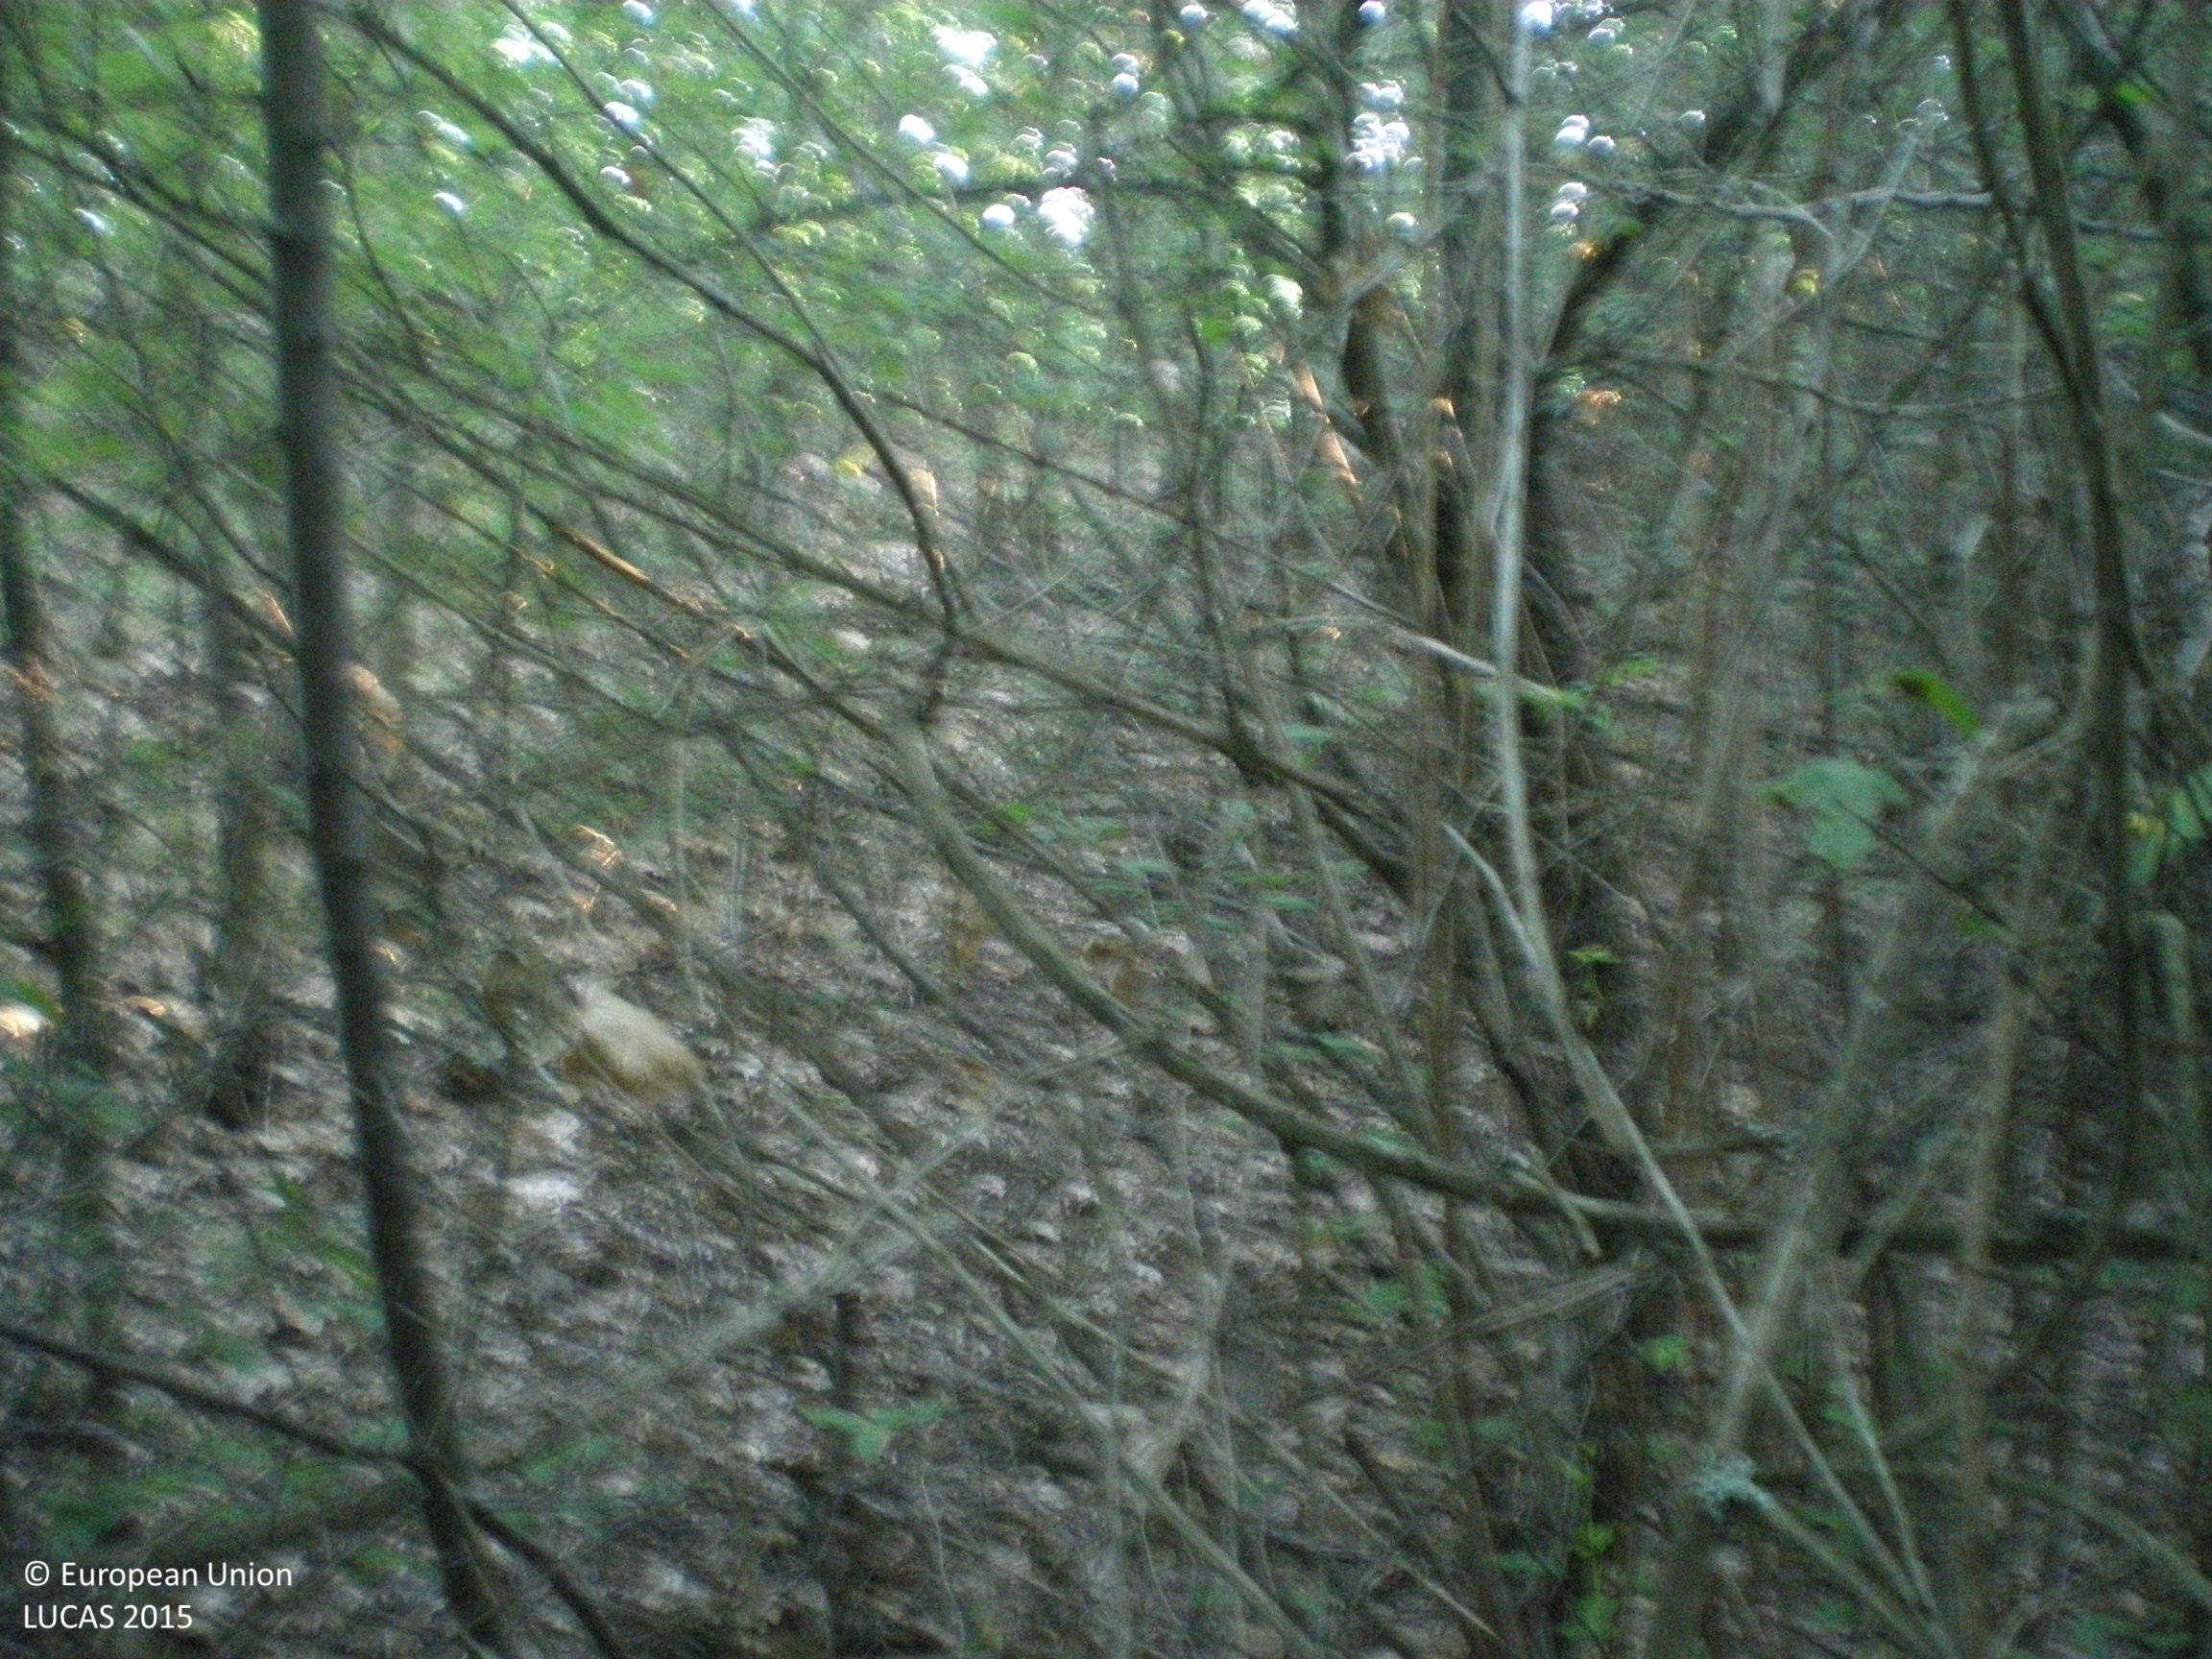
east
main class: Woodland
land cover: Broadleaved woodland
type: mesophytic deciduous forest
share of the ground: > 75 %
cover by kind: broadleaved forest trees 90 %, herbaceous plants 10 %
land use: Forestry
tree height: > 5 m
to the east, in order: Broadleaved woodland; Grassland without tree/shrub cover; Broadleaved woodland; Grassland without tree/shrub cover; Broadleaved woodland; Grassland without tree/shrub cover; Broadleaved woodland; Grassland without tree/shrub cover; Broadleaved woodland
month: June
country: BG
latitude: 42.4246
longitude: 25.1452
